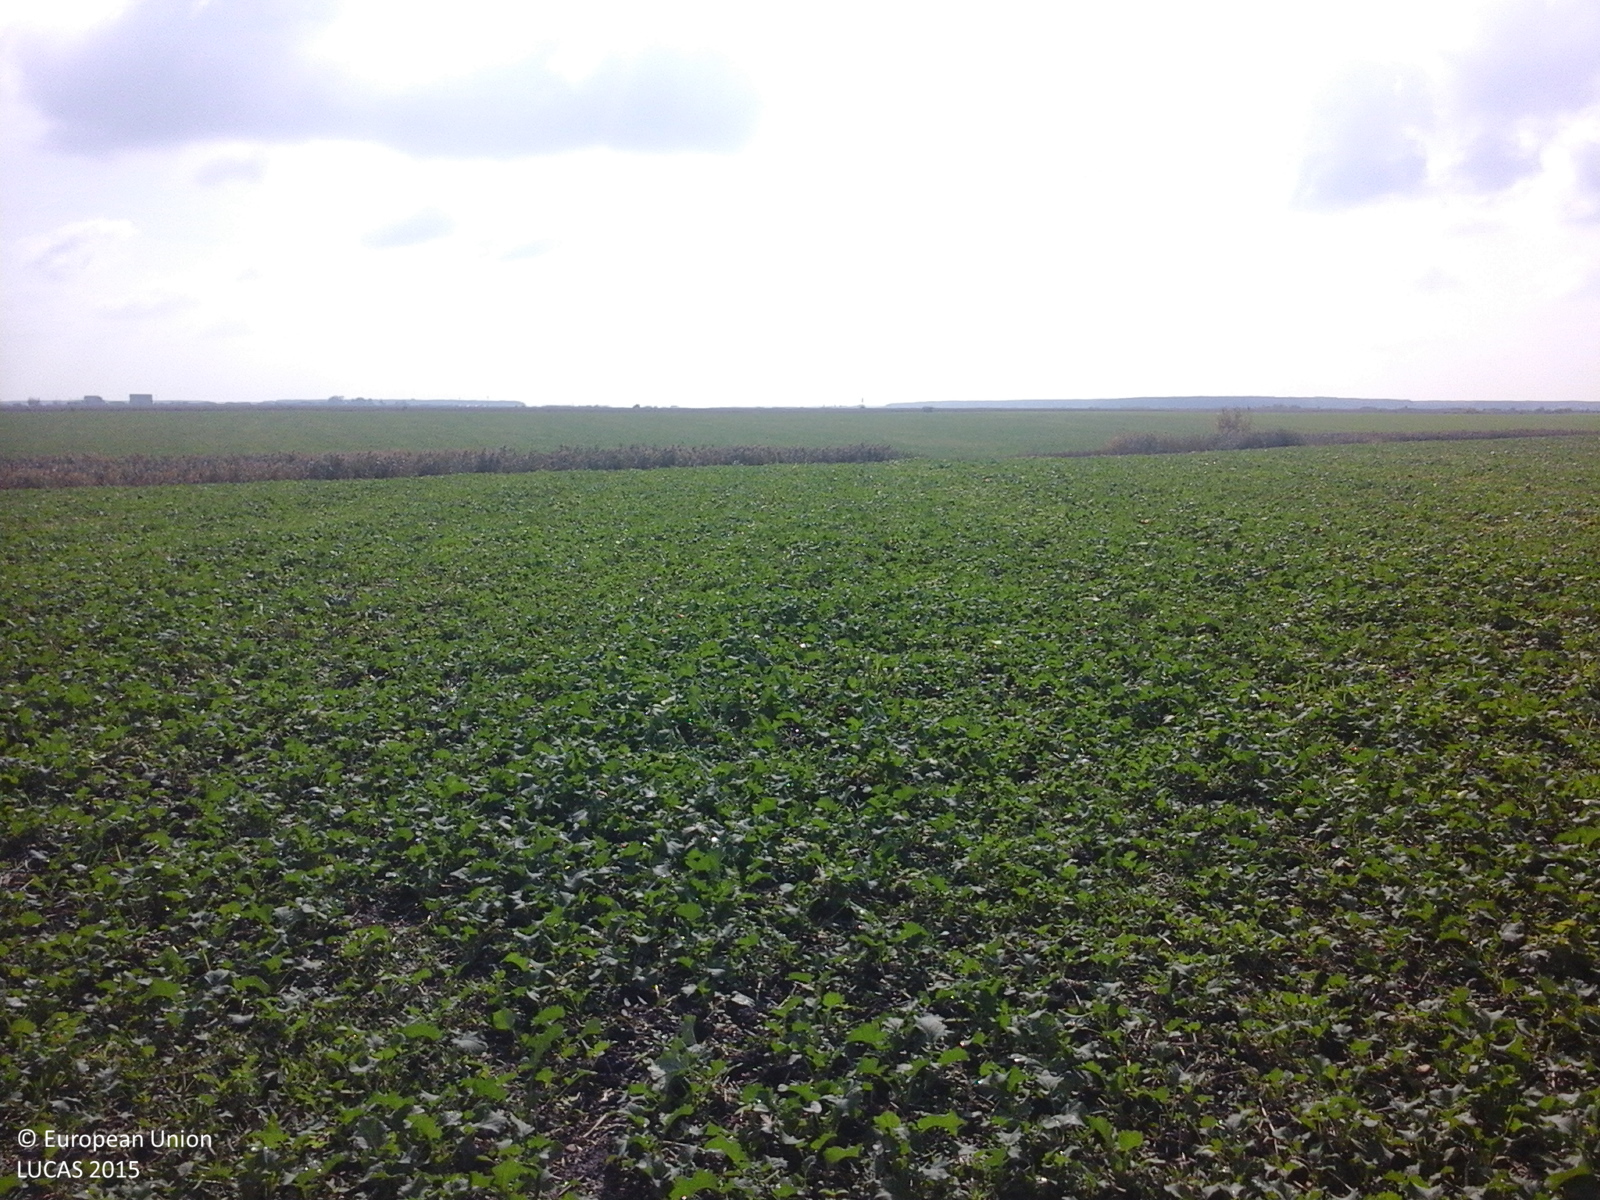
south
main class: Cropland
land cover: Rape and turnip rape
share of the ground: > 75 %
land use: Agriculture (excluding fallow land and kitchen gardens)
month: October
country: RO
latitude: 44.6409
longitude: 26.0027
